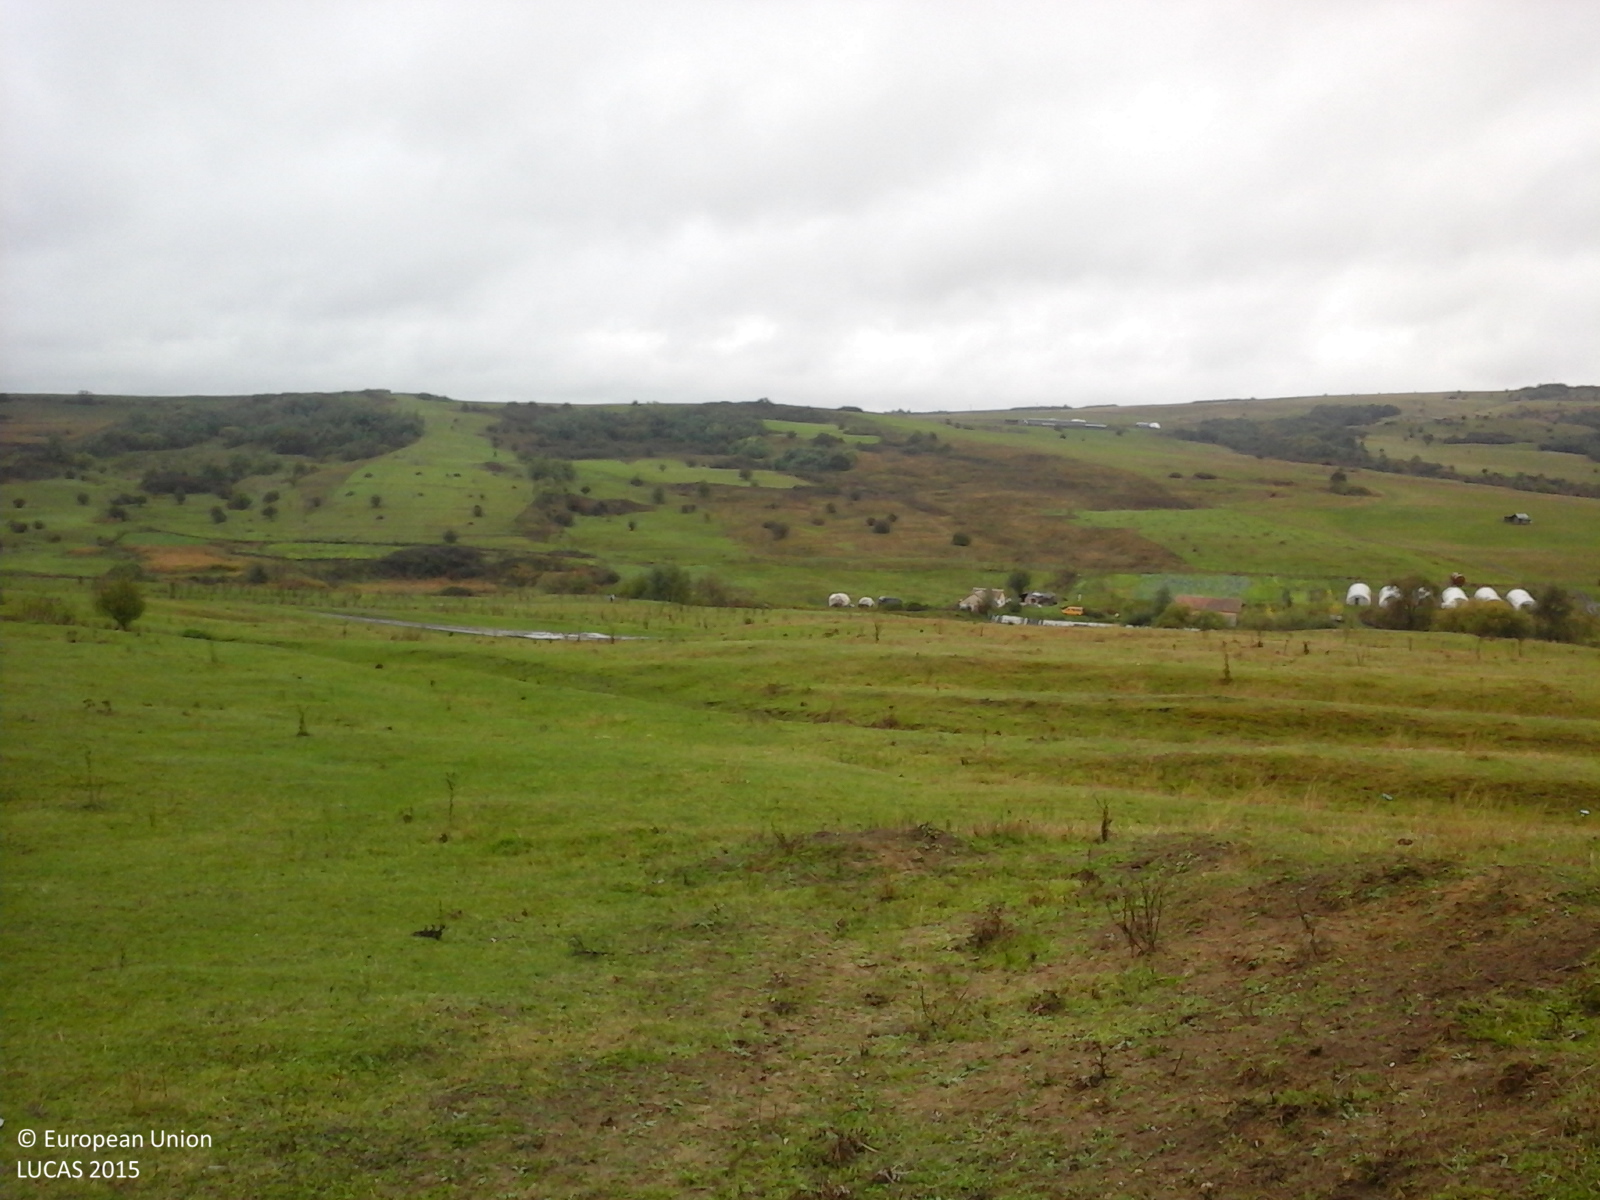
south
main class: Grassland
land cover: Grassland without tree/shrub cover
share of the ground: > 75 %
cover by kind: herbaceous plants 100 %
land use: Agriculture (excluding fallow land and kitchen gardens)
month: October
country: RO
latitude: 45.8781
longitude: 24.0267
